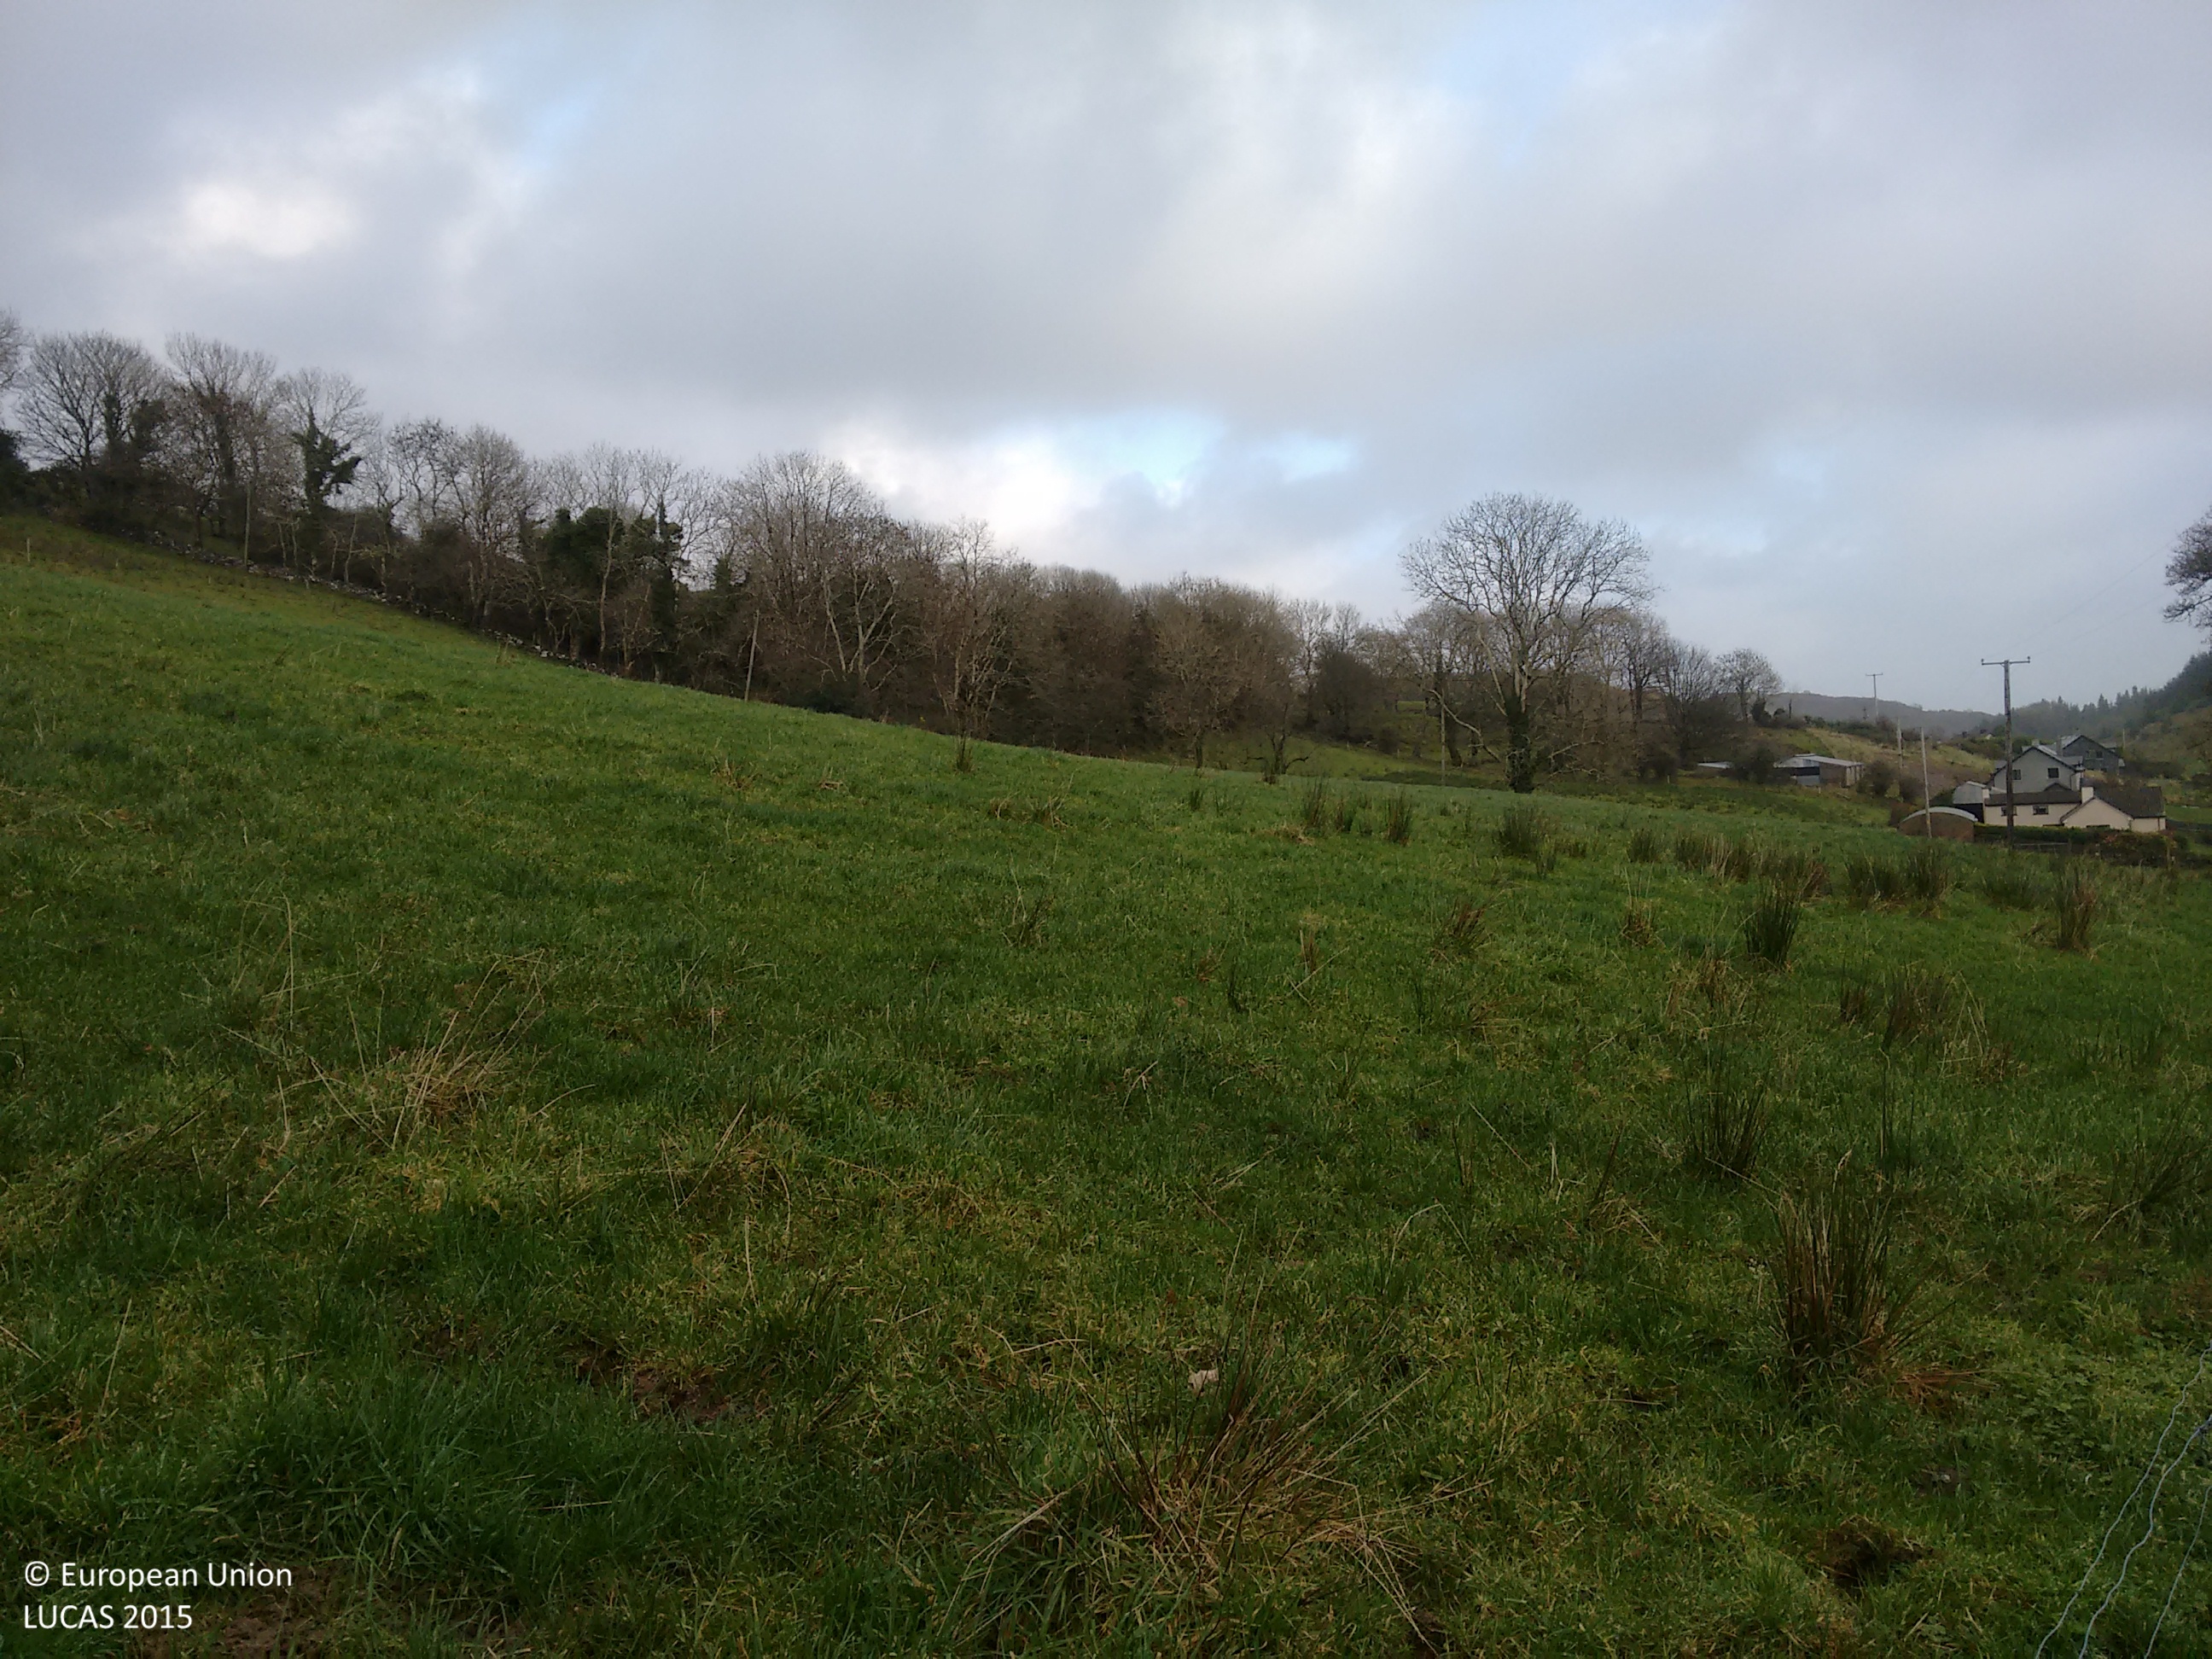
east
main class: Grassland
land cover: Grassland without tree/shrub cover
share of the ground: > 75 %
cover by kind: herbaceous plants 100 %
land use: Agriculture (excluding fallow land and kitchen gardens)
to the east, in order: Grassland without tree/shrub cover; Fences; Grassland without tree/shrub cover; Electric lines; Dry stone walls; Fences; Broadleaved woodland; Shrubland without tree cover; Lines of trees; Fences; Dry stone walls; Grassland without tree/shrub cover
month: November
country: IE
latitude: 54.2852
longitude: -8.3903
